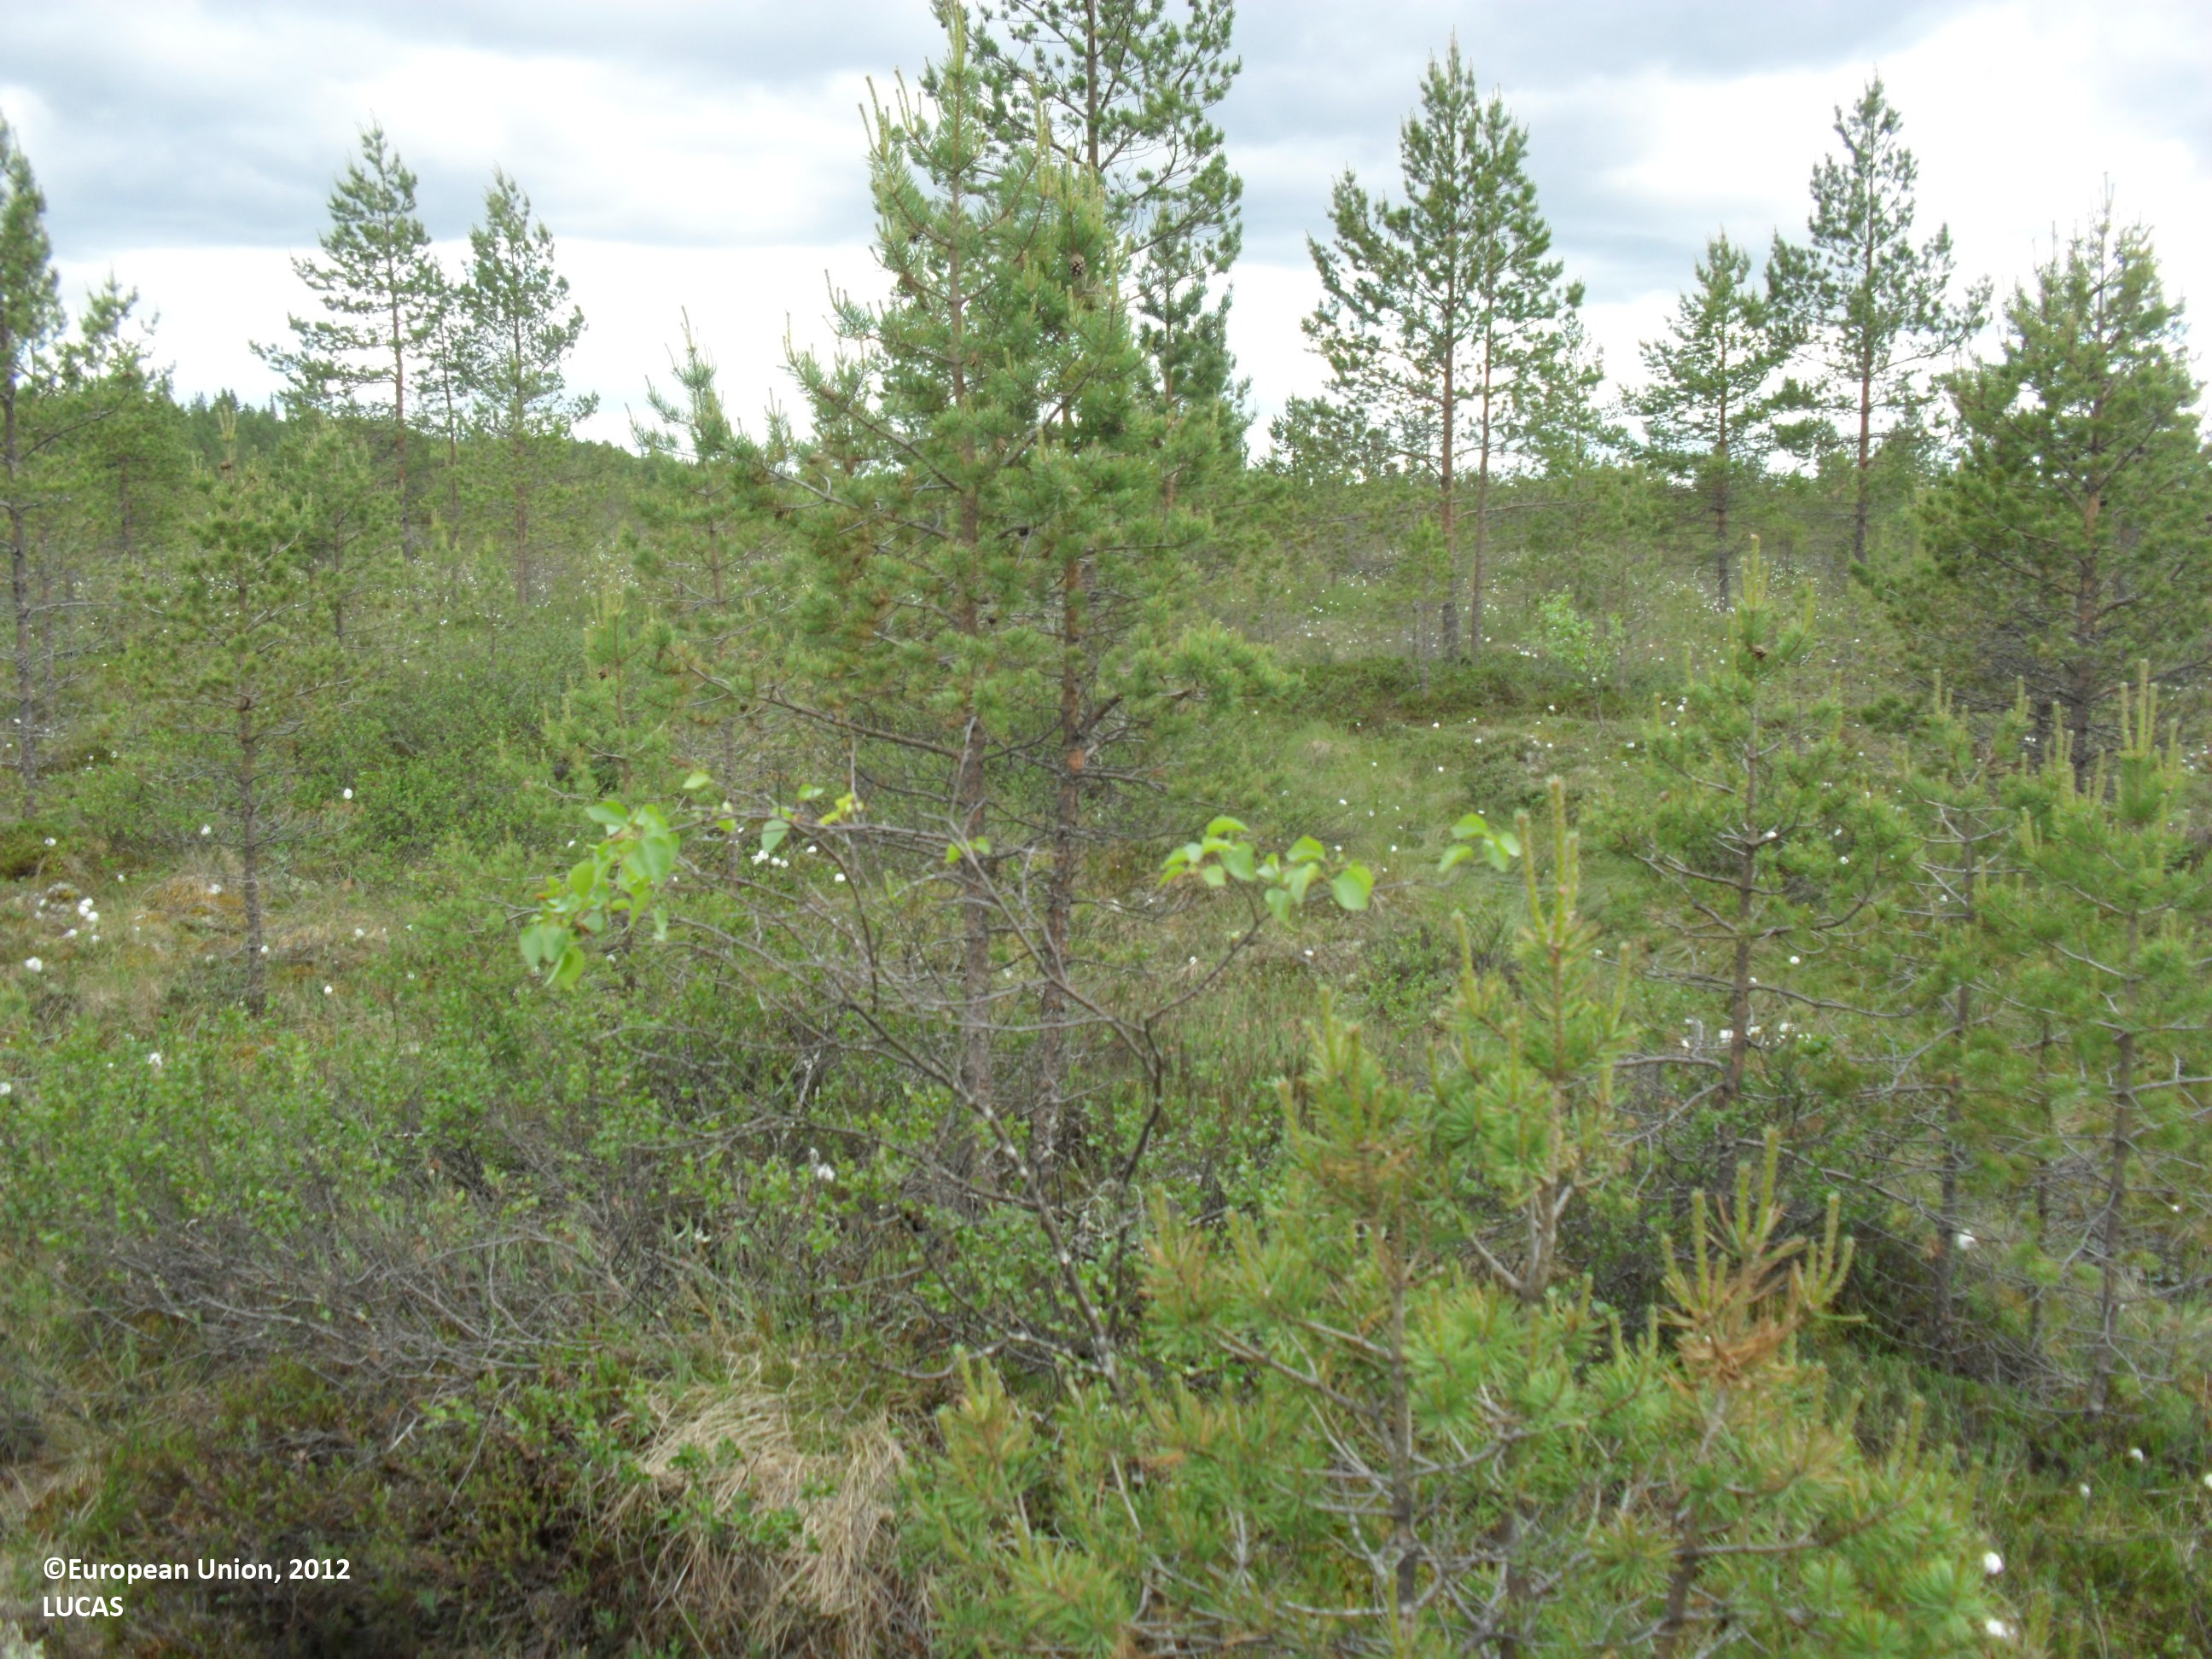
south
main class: Woodland
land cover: Pine dominated coniferous woodland
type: mire and swamp forests
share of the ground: 10 - 25 %
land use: Forestry
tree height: < 5 m
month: June
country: FI
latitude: 63.1762
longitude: 23.0687
